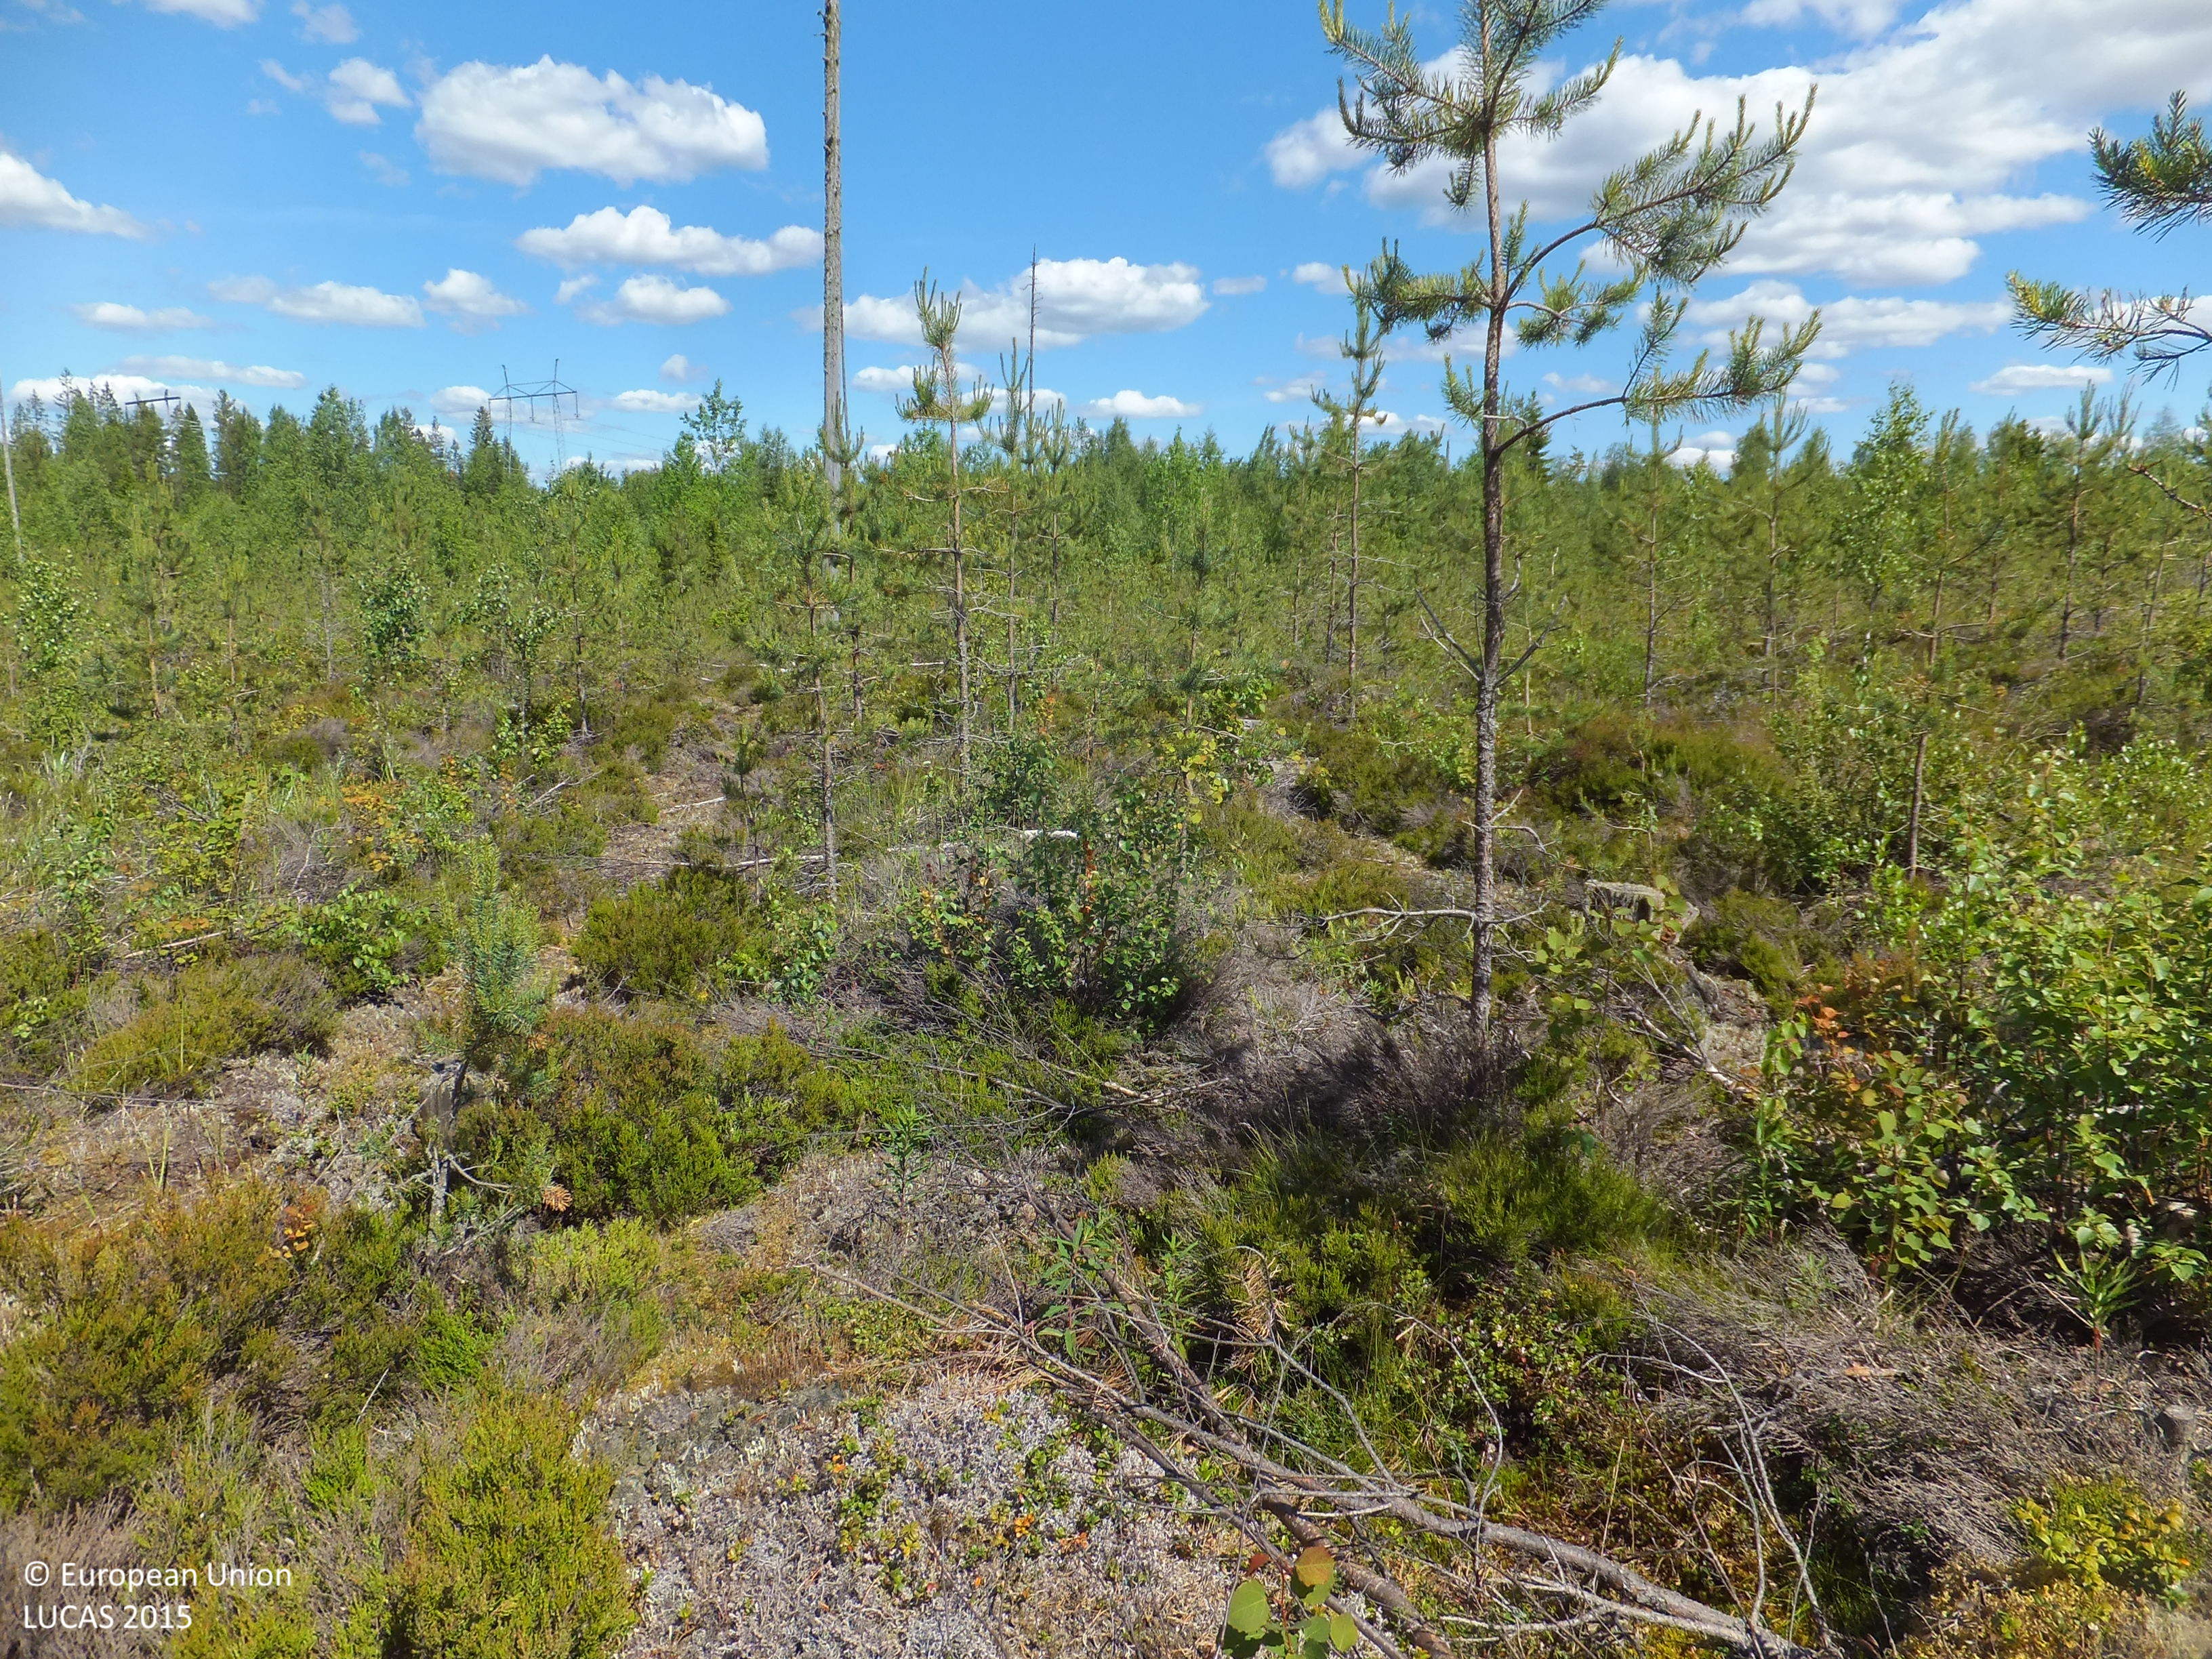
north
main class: Woodland
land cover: Pine dominated mixed woodland
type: boreal forest
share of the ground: 25 - 50 %
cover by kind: shrubs 35 %, coniferous forest trees 25 %, lichens and mosses 20 %, broadleaved forest trees 15 %, herbaceous plants 5 %
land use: Forestry
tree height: < 5 m
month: July
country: FI
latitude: 63.0120
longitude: 24.0807
